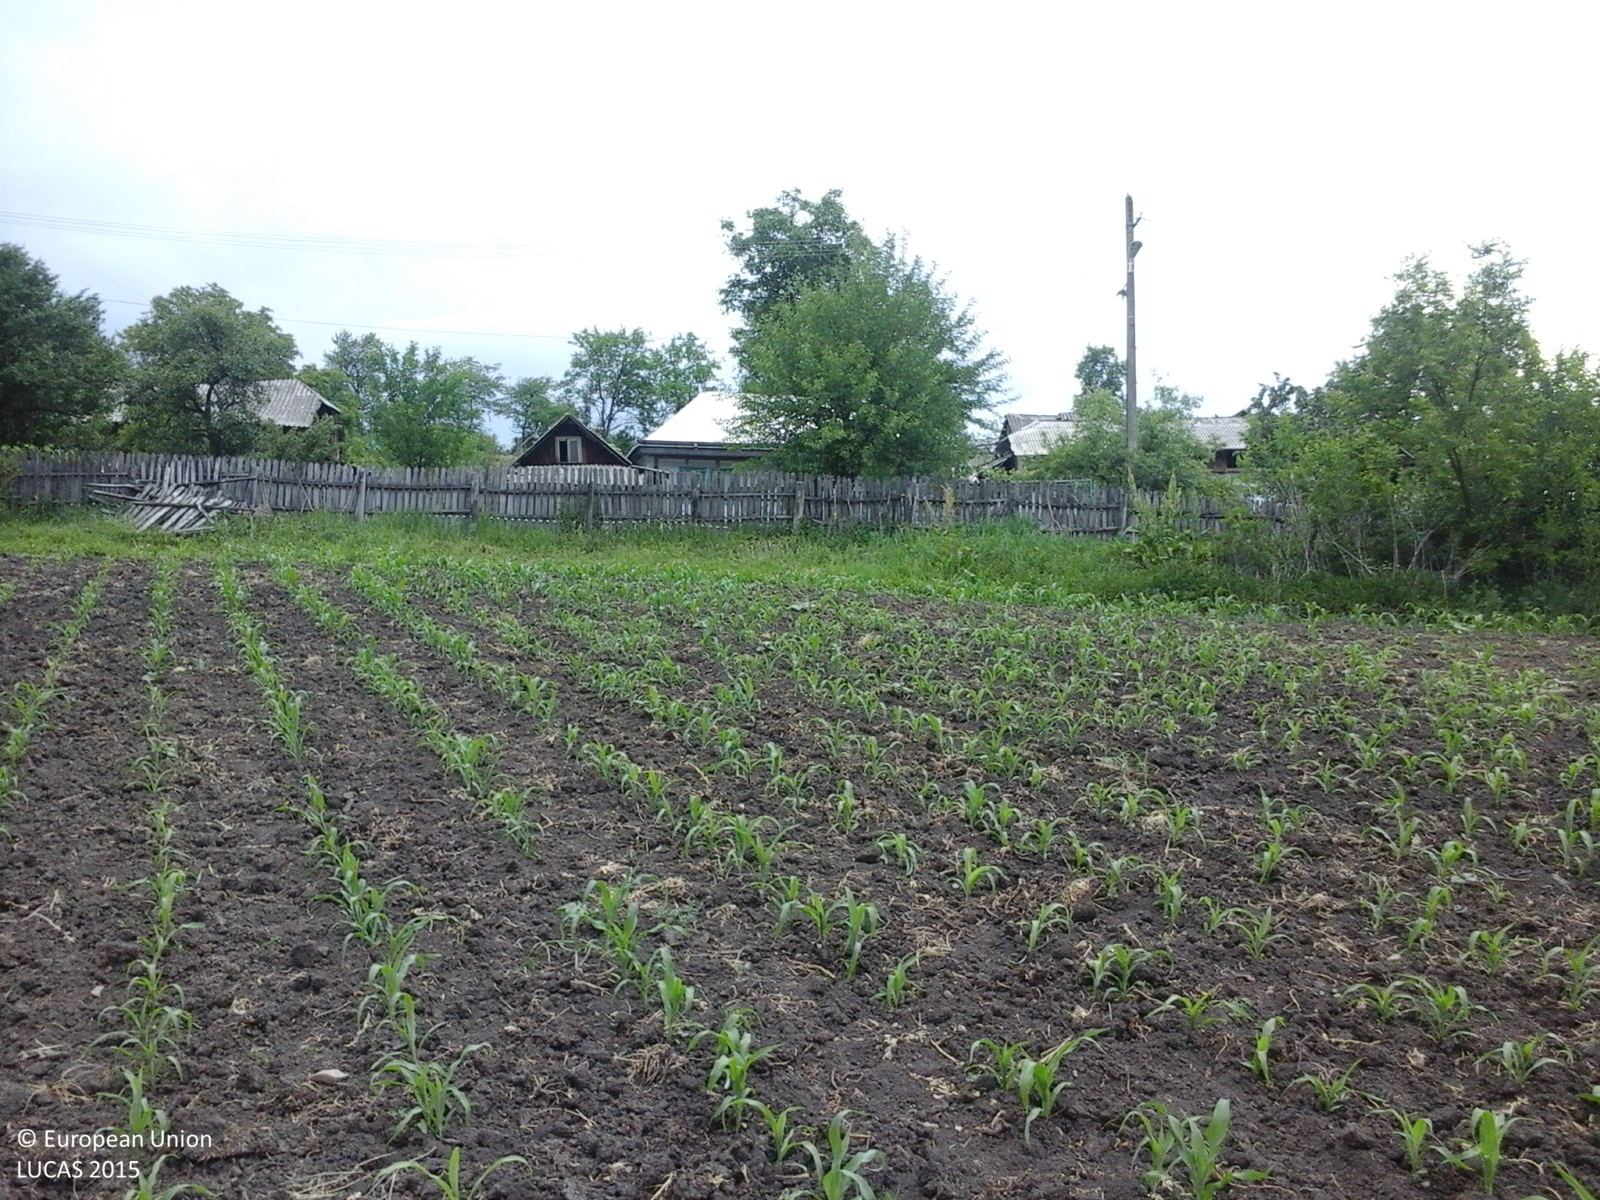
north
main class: Cropland
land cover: Maize
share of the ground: 10 - 25 %
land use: Agriculture (excluding fallow land and kitchen gardens)
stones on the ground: < 10 %
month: June
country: RO
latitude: 46.5060
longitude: 26.7566
